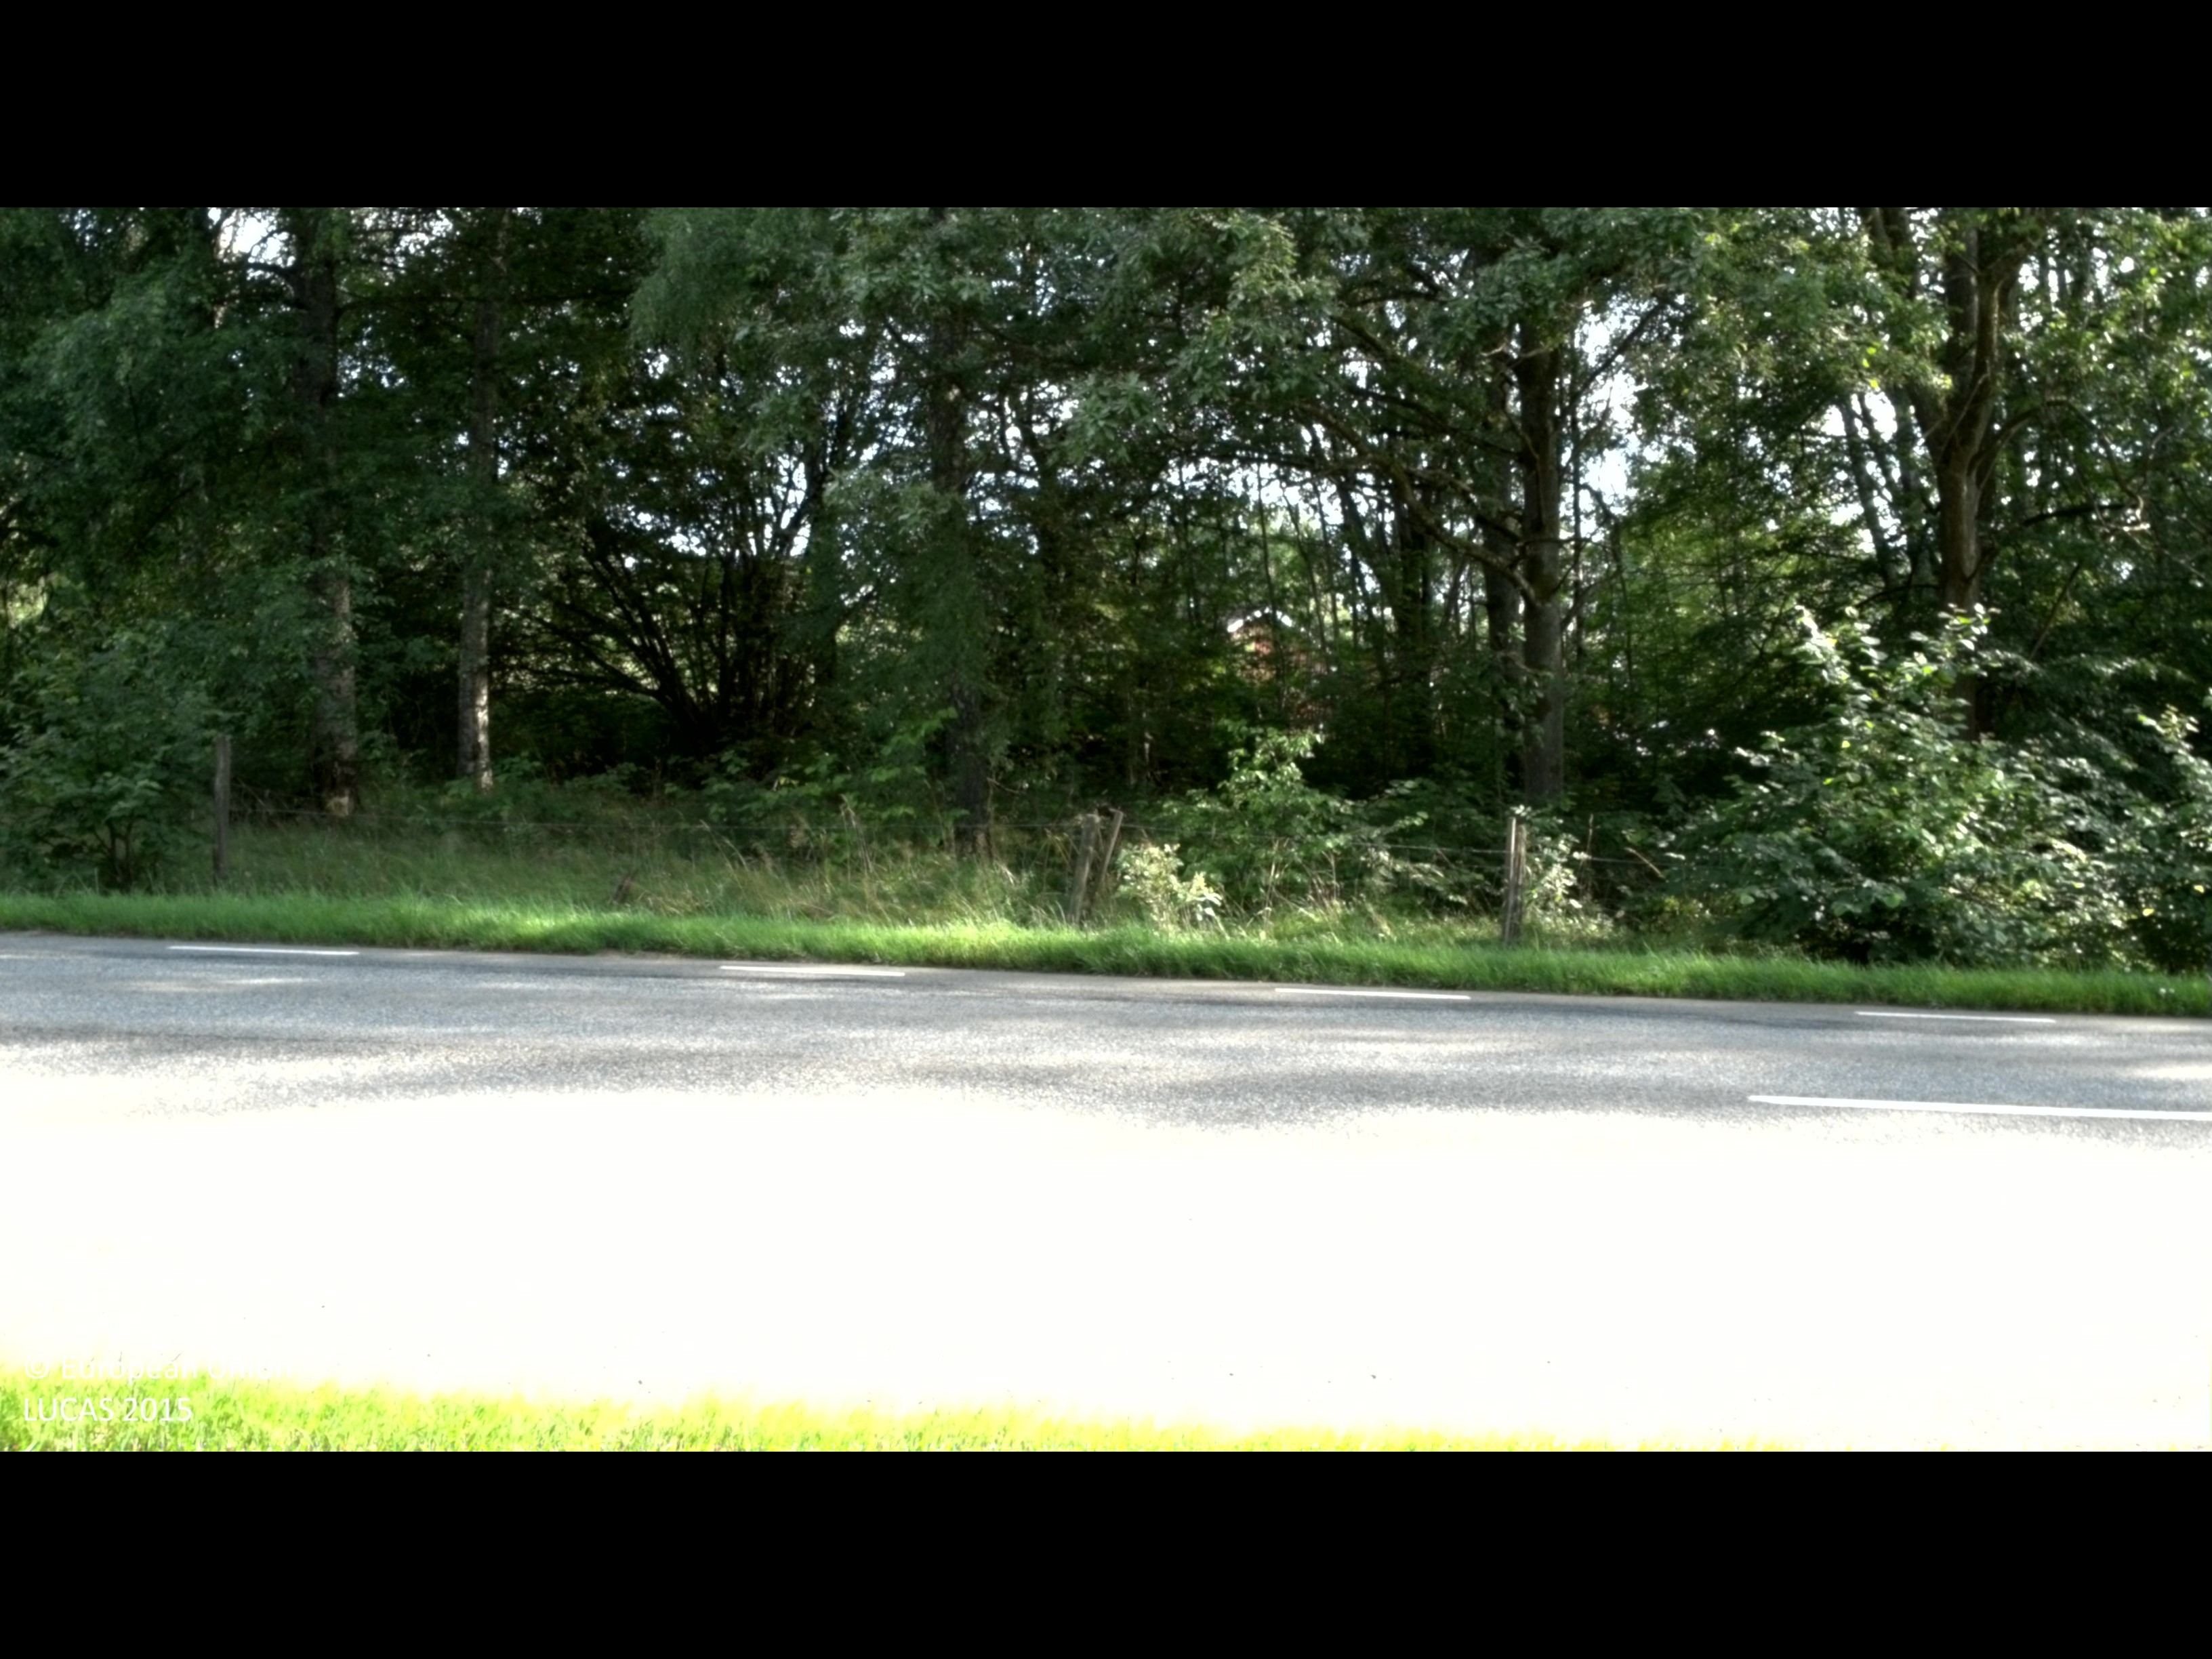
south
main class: Woodland
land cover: Broadleaved woodland
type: boreal forest
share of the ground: 50 - 75 %
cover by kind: broadleaved forest trees 60 %, herbaceous plants 30 %, shrubs 10 %
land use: Residential
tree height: > 5 m
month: August
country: SE
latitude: 56.8221
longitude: 14.1748
